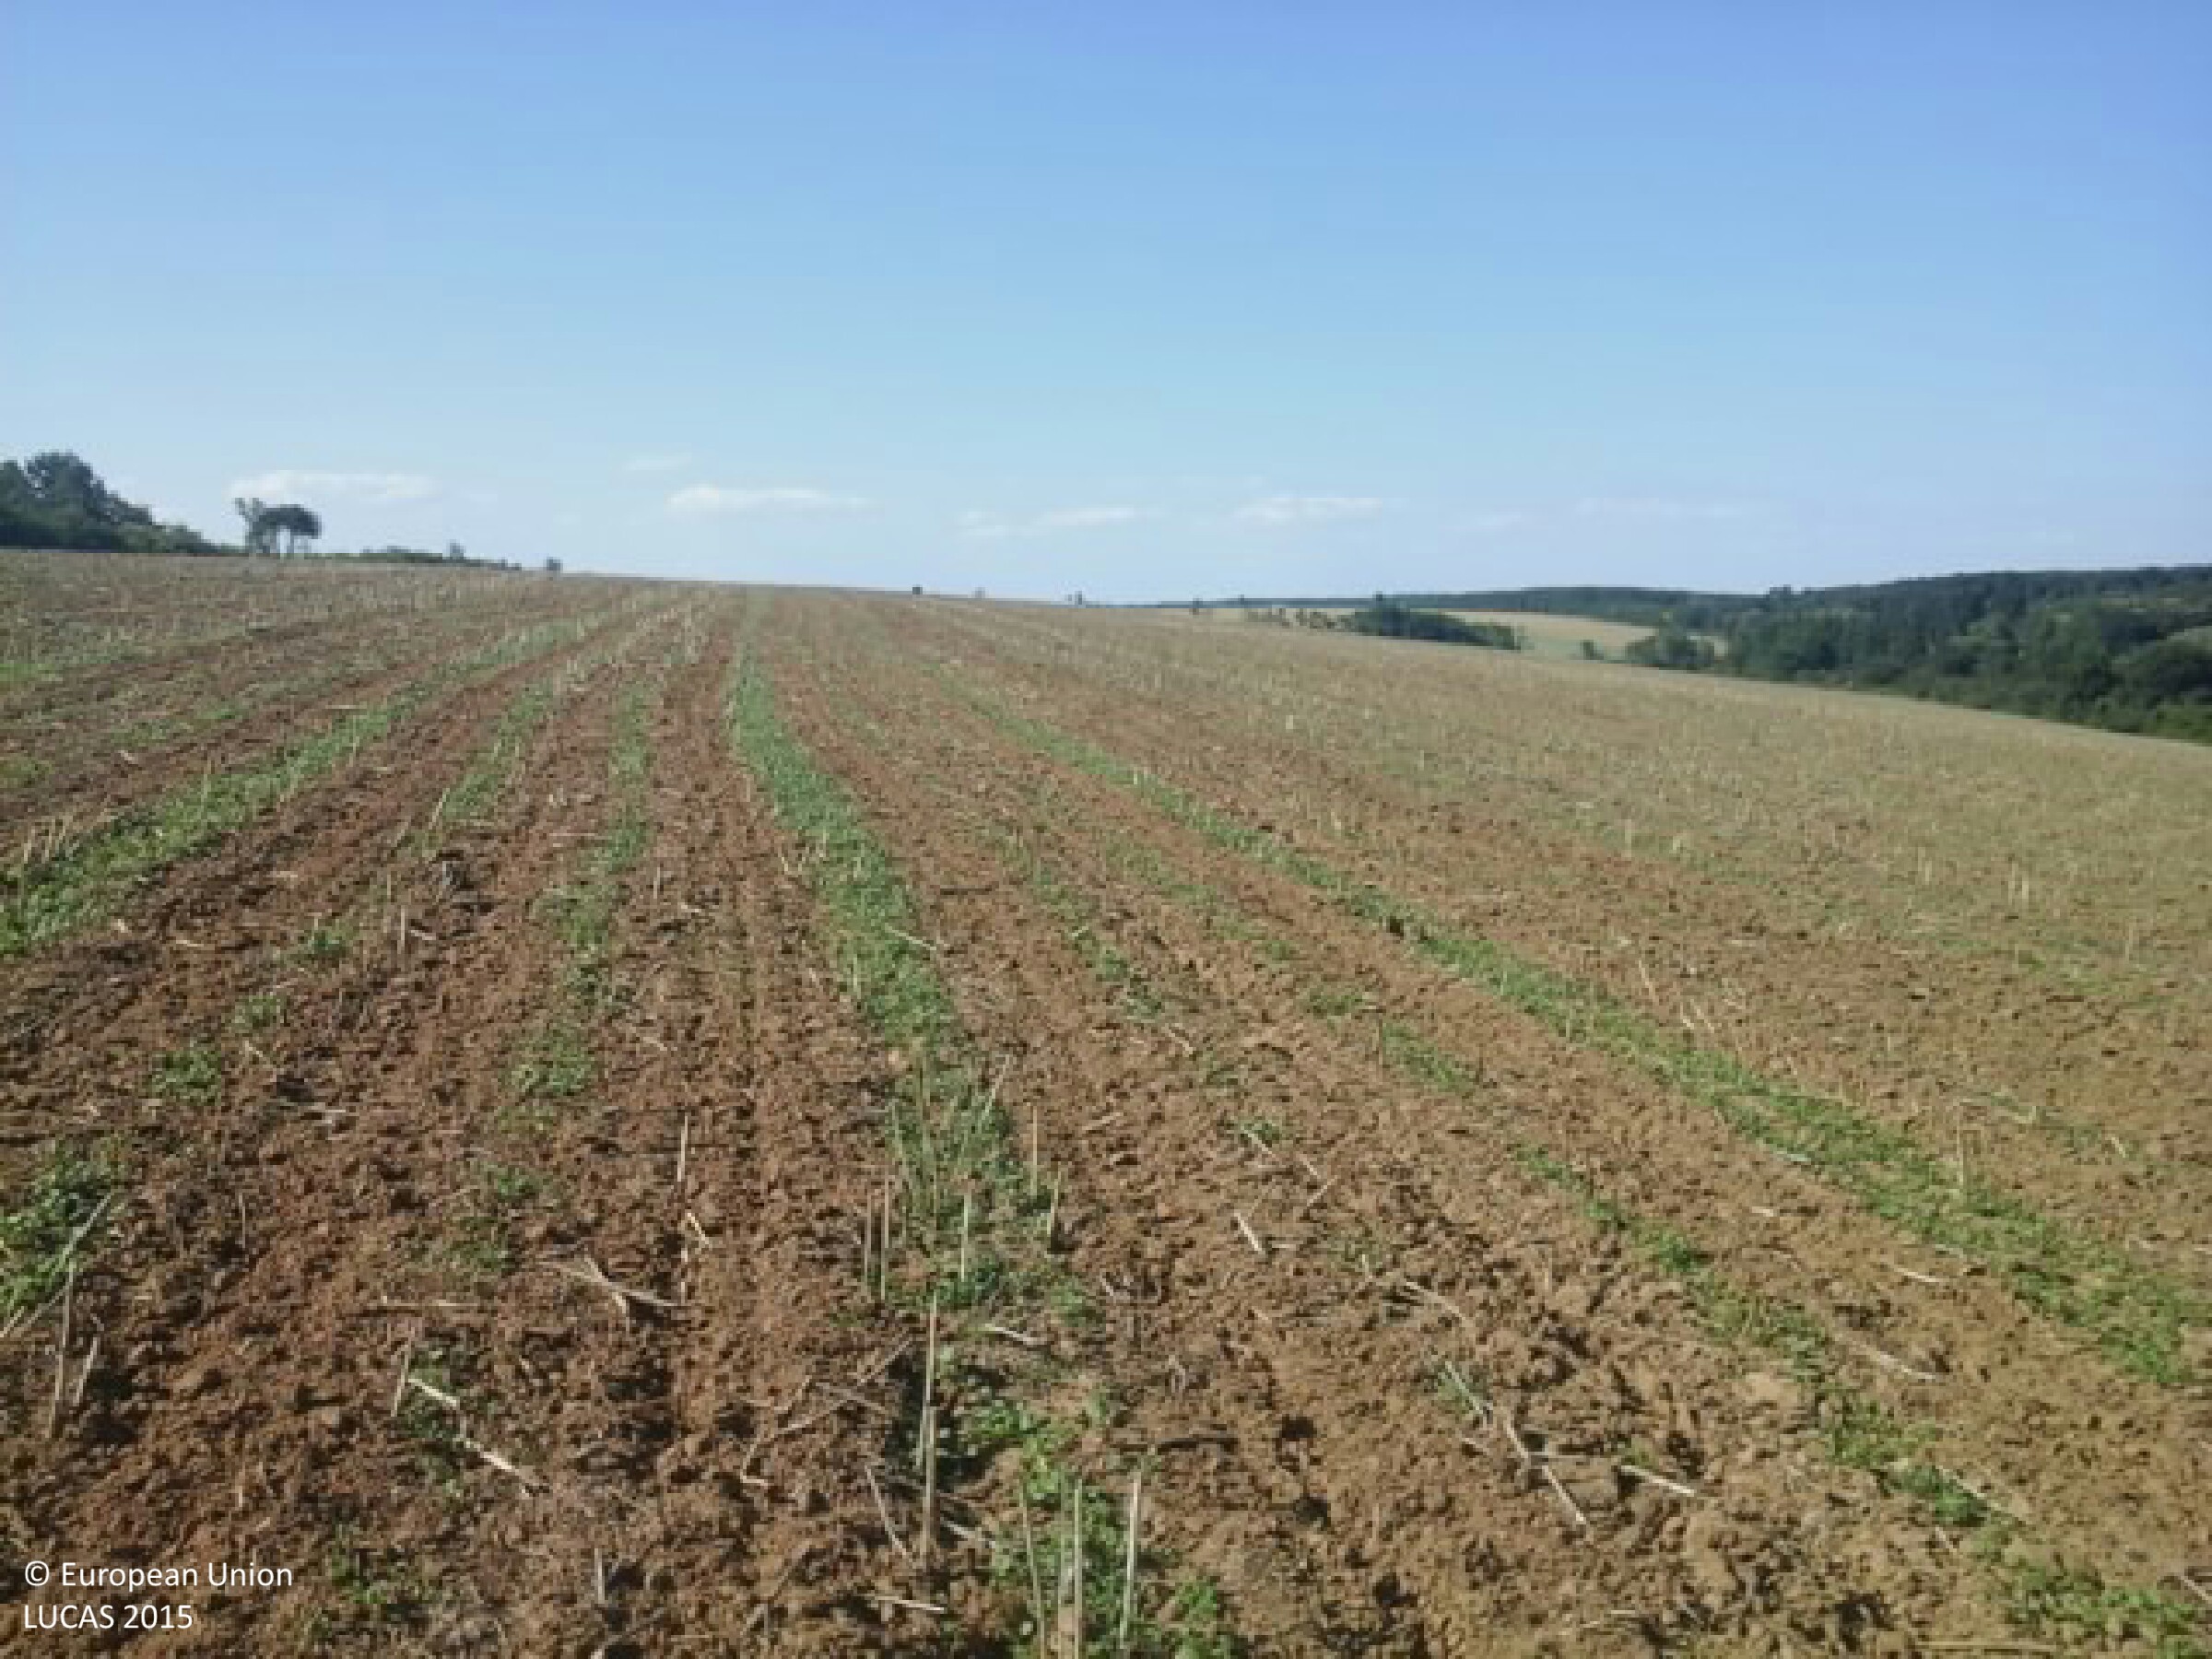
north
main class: Cropland
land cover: Common wheat
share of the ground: < 10 %
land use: Agriculture (excluding fallow land and kitchen gardens)
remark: Harvested field
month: July
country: HU
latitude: 46.4853
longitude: 17.7570
